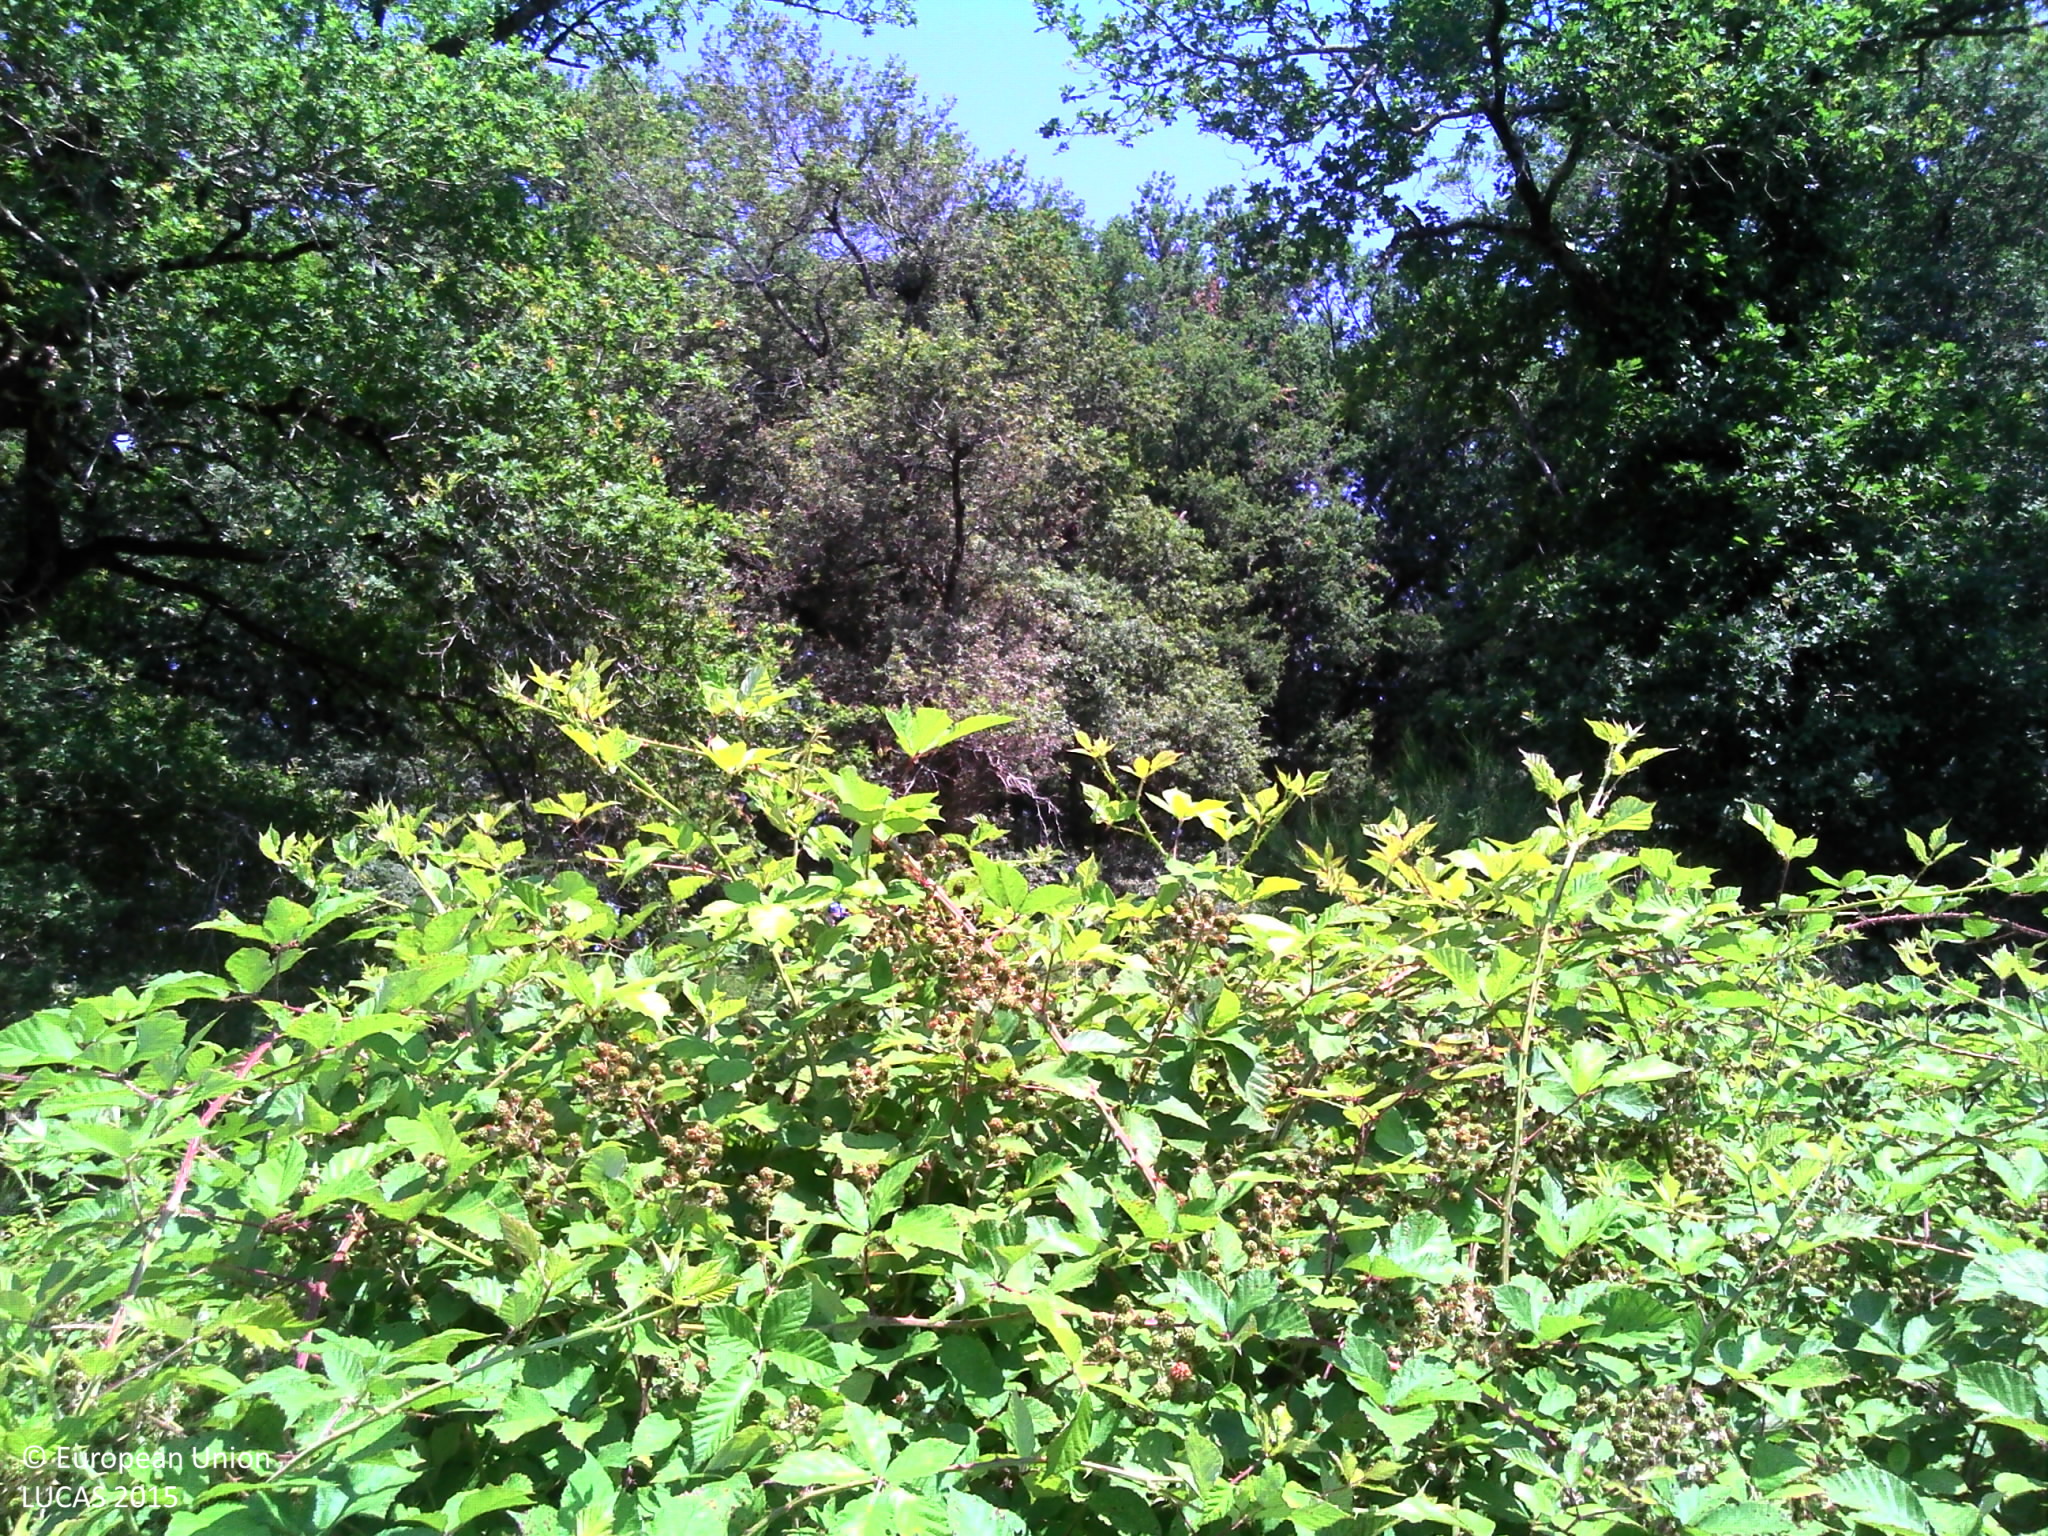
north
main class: Shrubland
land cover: Shrubland without tree cover
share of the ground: > 75 %
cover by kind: shrubs 55 %, herbaceous plants 45 %
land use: Abandoned areas
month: June
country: FR
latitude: 43.6465
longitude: -0.5610
